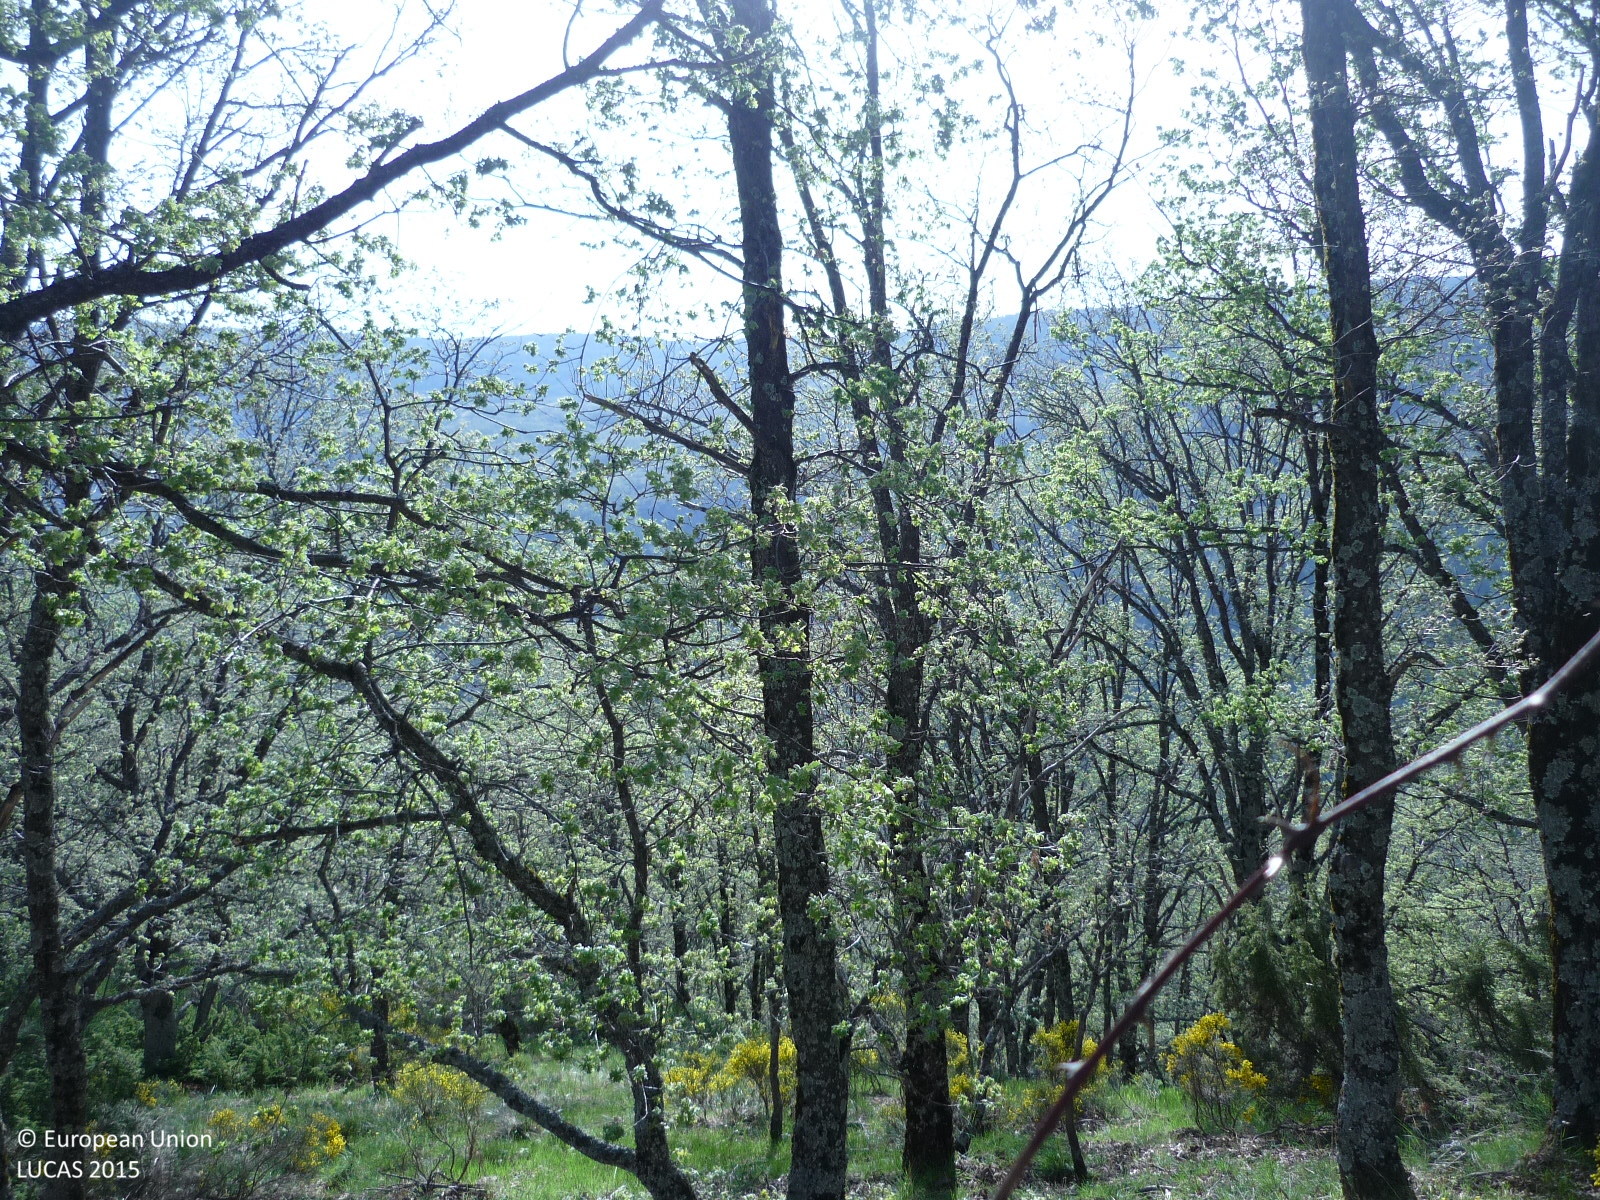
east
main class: Woodland
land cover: Broadleaved woodland
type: thermophilous deciduous forest
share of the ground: > 75 %
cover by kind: broadleaved forest trees 85 %, shrubs 10 %, herbaceous plants 5 %
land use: Semi-natural and natural areas not in use
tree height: > 5 m
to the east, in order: Broadleaved woodland; Grass margins; Paved roads, cycling and walking lanes; Grass margins; Fences; Broadleaved woodland
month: May
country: ES
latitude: 40.8743
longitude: -3.8455
